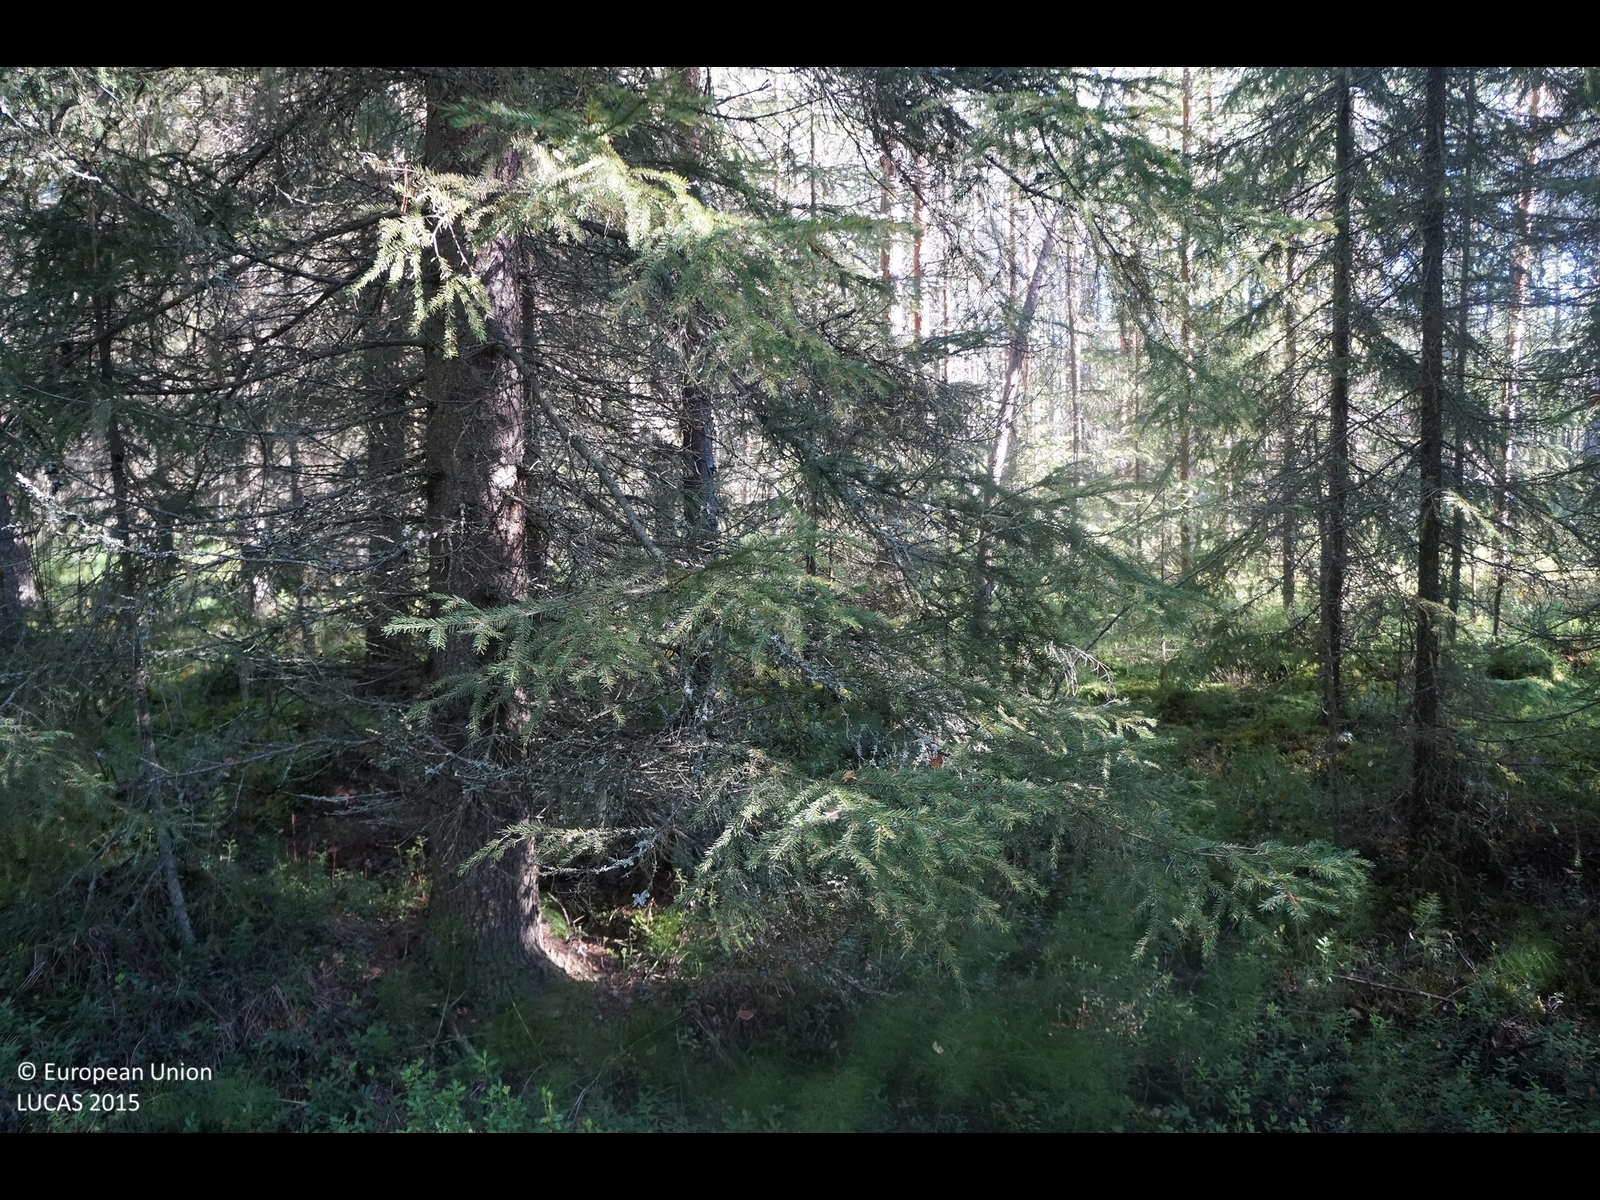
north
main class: Woodland
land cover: Other mixed woodland
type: boreal forest
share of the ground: 50 - 75 %
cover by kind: coniferous forest trees 50 %, broadleaved forest trees 20 %, shrubs 20 %, lichens and mosses 10 %
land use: Forestry
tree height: > 5 m
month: August
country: FI
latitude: 64.2933
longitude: 26.2480
